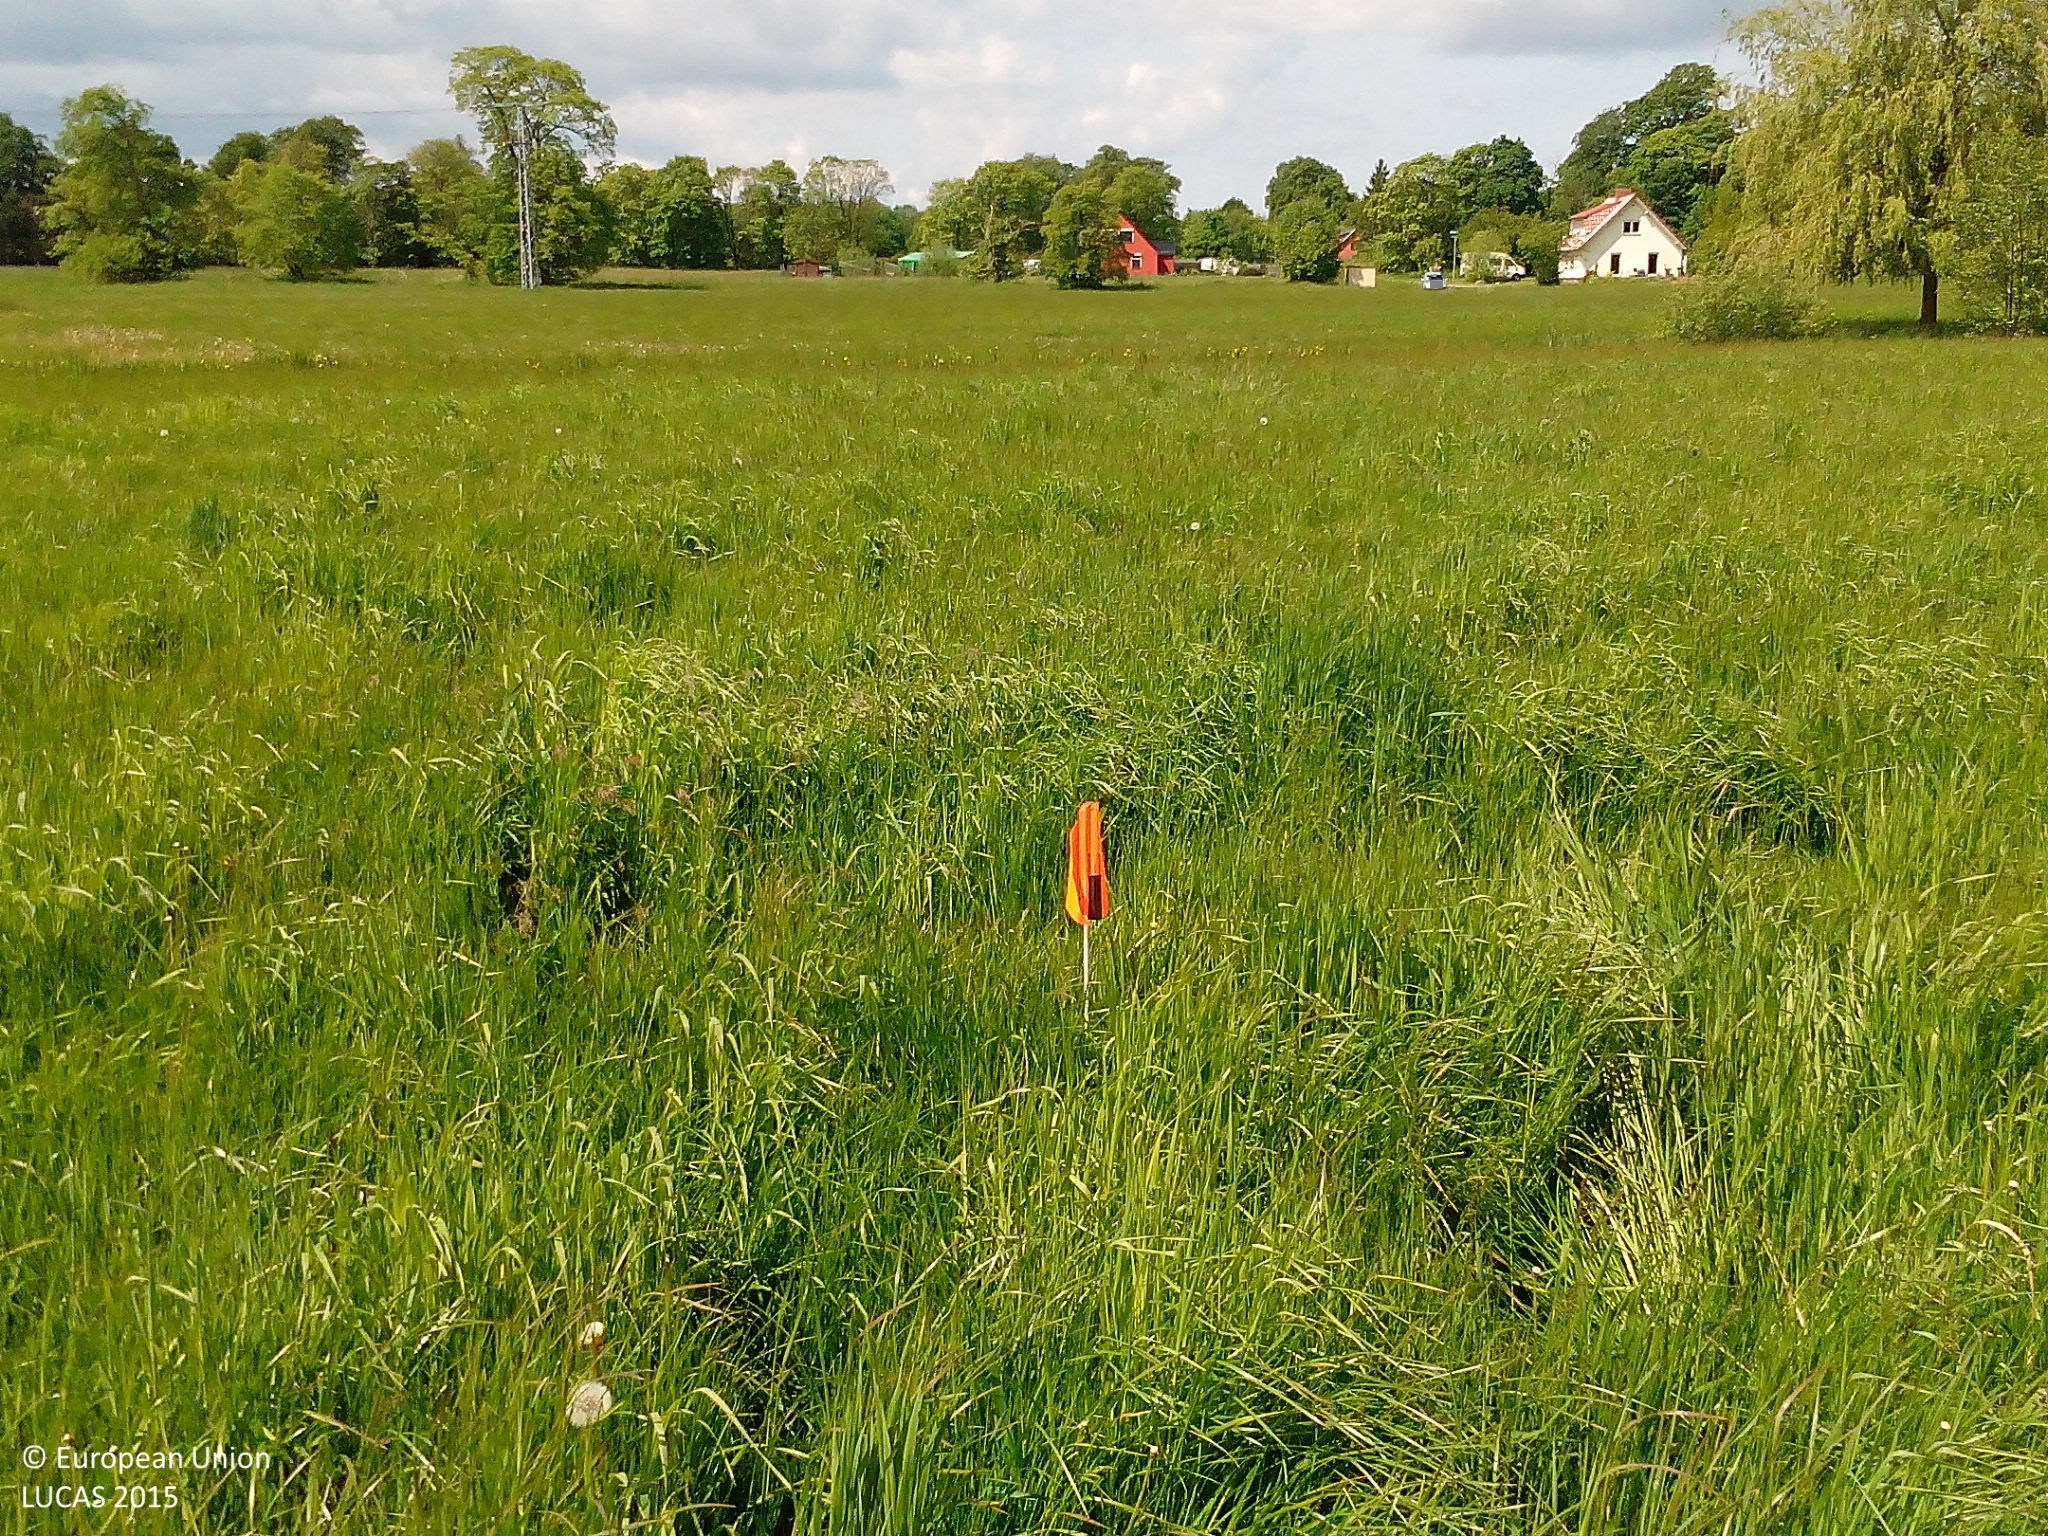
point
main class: Grassland
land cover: Grassland without tree/shrub cover
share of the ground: > 75 %
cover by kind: herbaceous plants 100 %
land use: Agriculture (excluding fallow land and kitchen gardens)
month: May
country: DE
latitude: 54.4539
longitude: 13.3153
